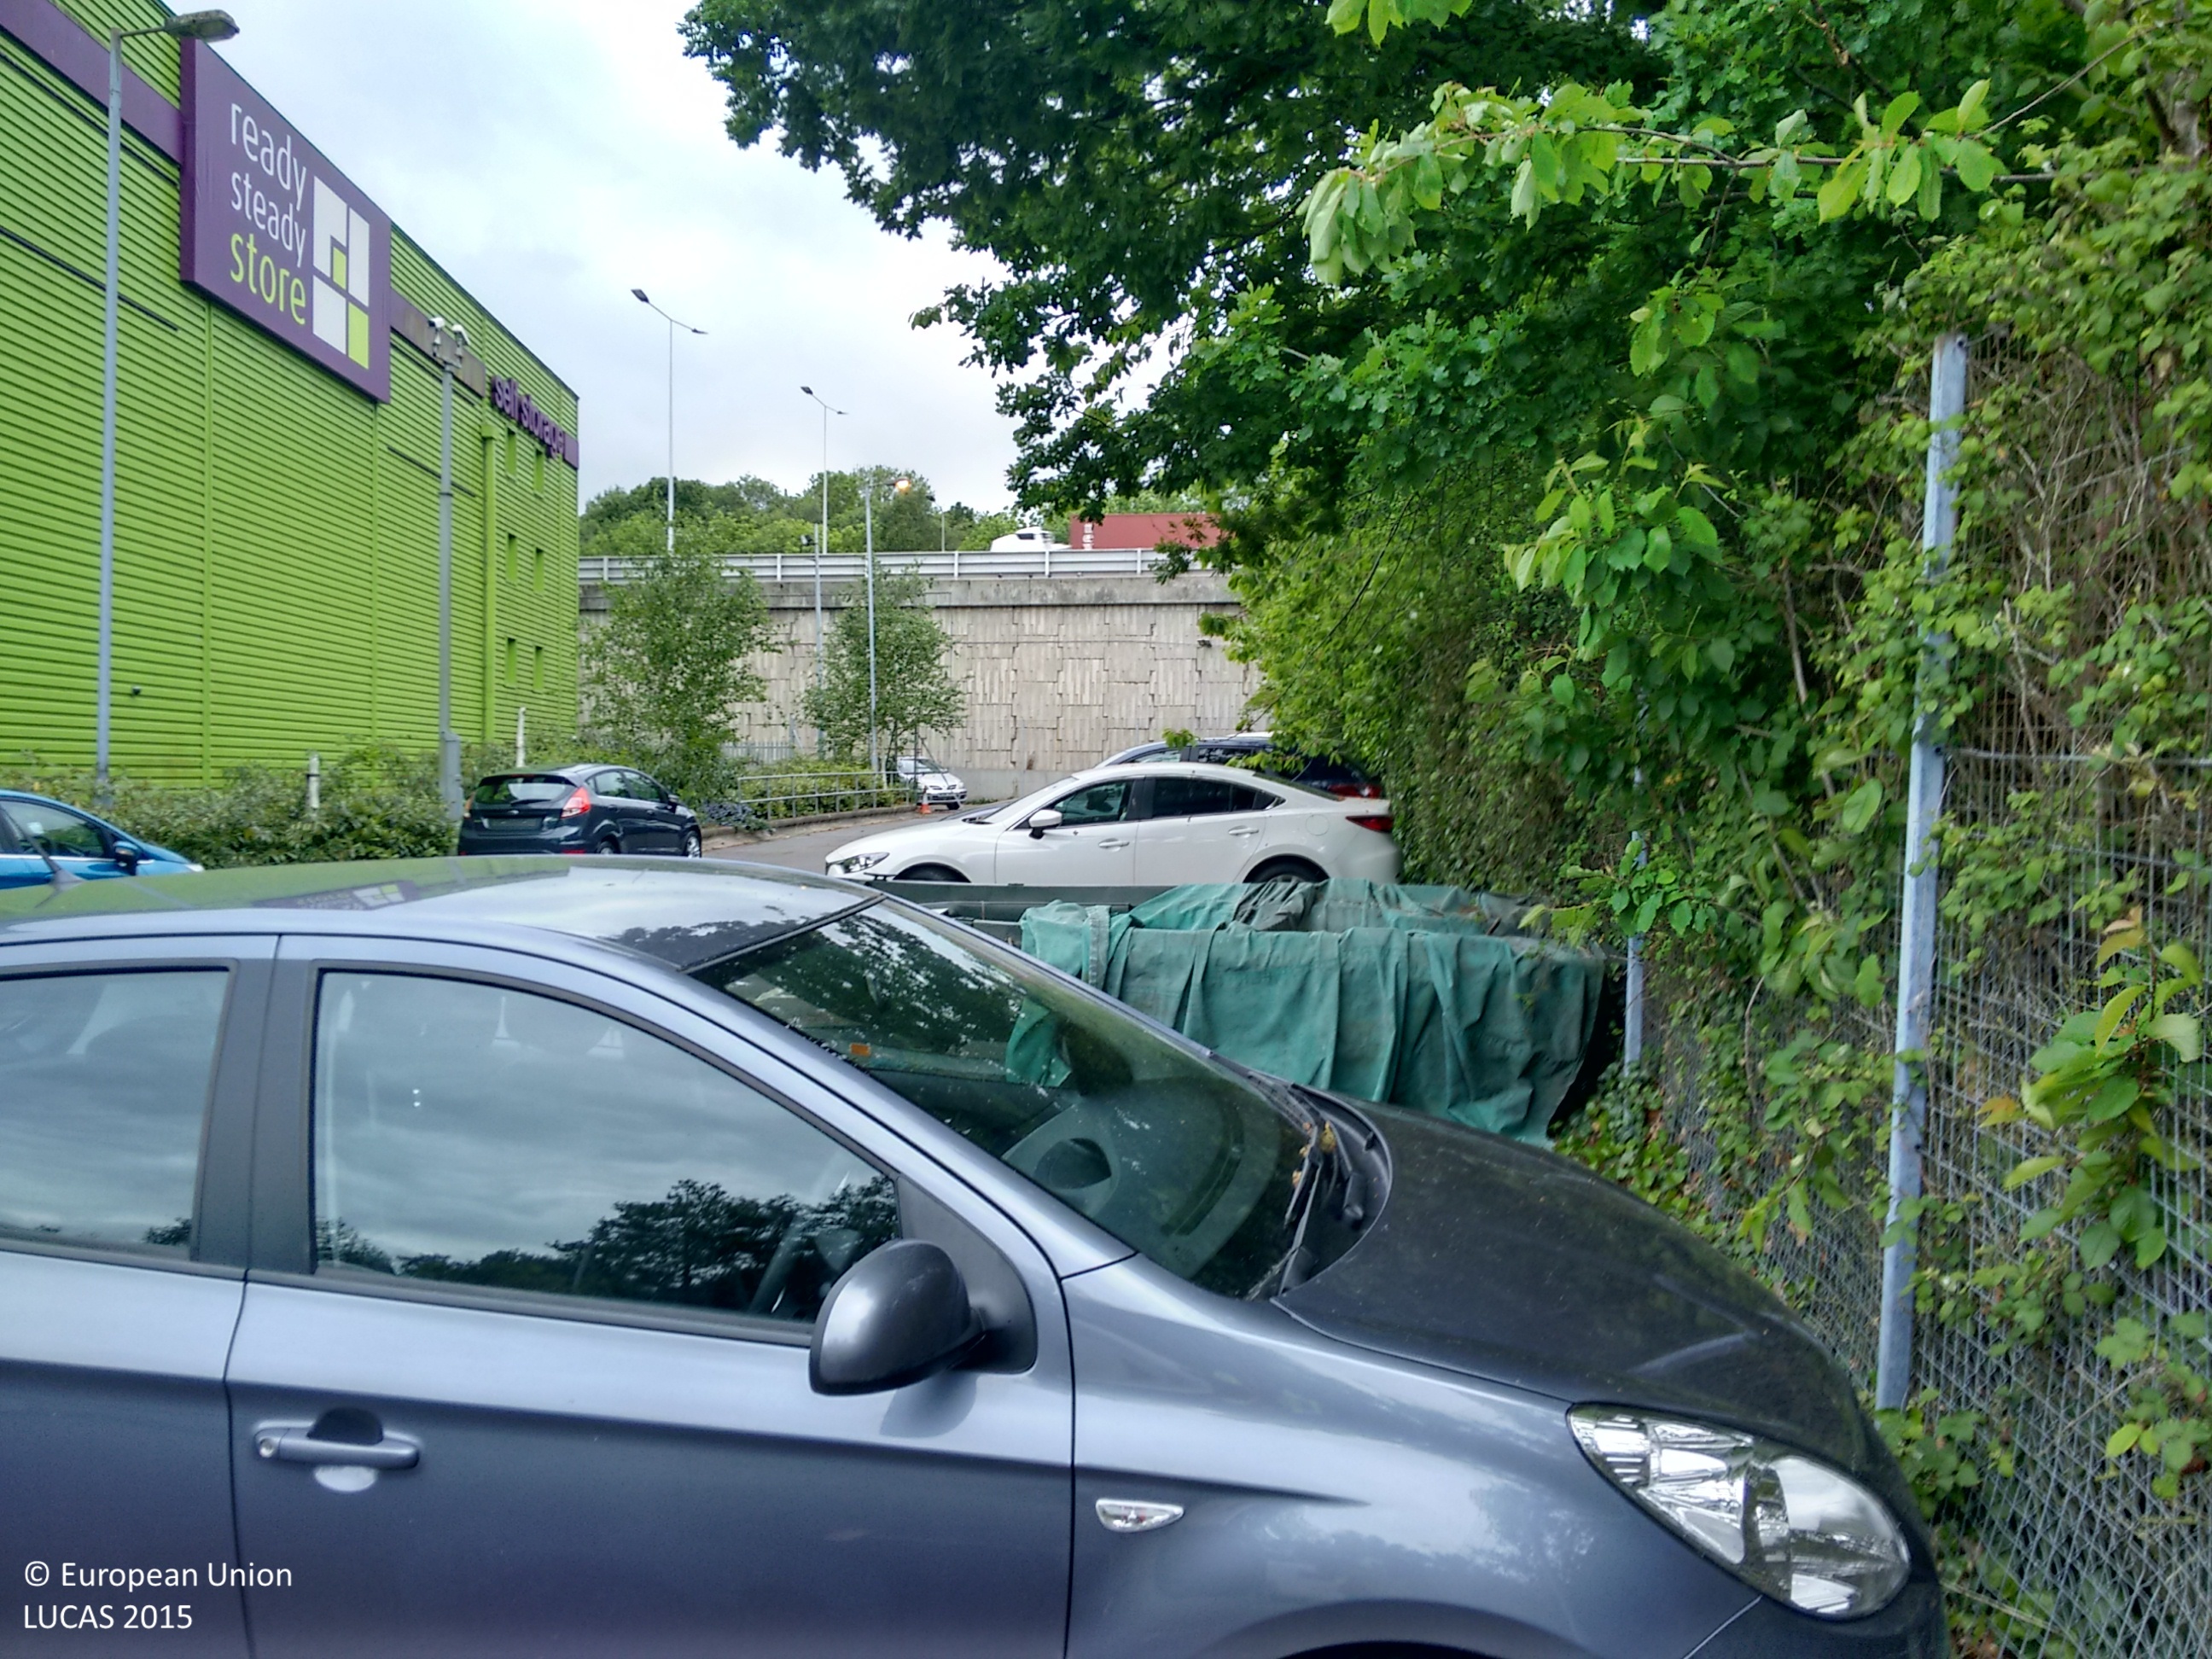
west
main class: Woodland
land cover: Broadleaved woodland
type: mesophytic deciduous forest
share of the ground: > 75 %
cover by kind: broadleaved forest trees 100 %
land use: Semi-natural and natural areas not in use
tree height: > 5 m
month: May
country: GB
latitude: 50.9754
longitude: -1.3718
